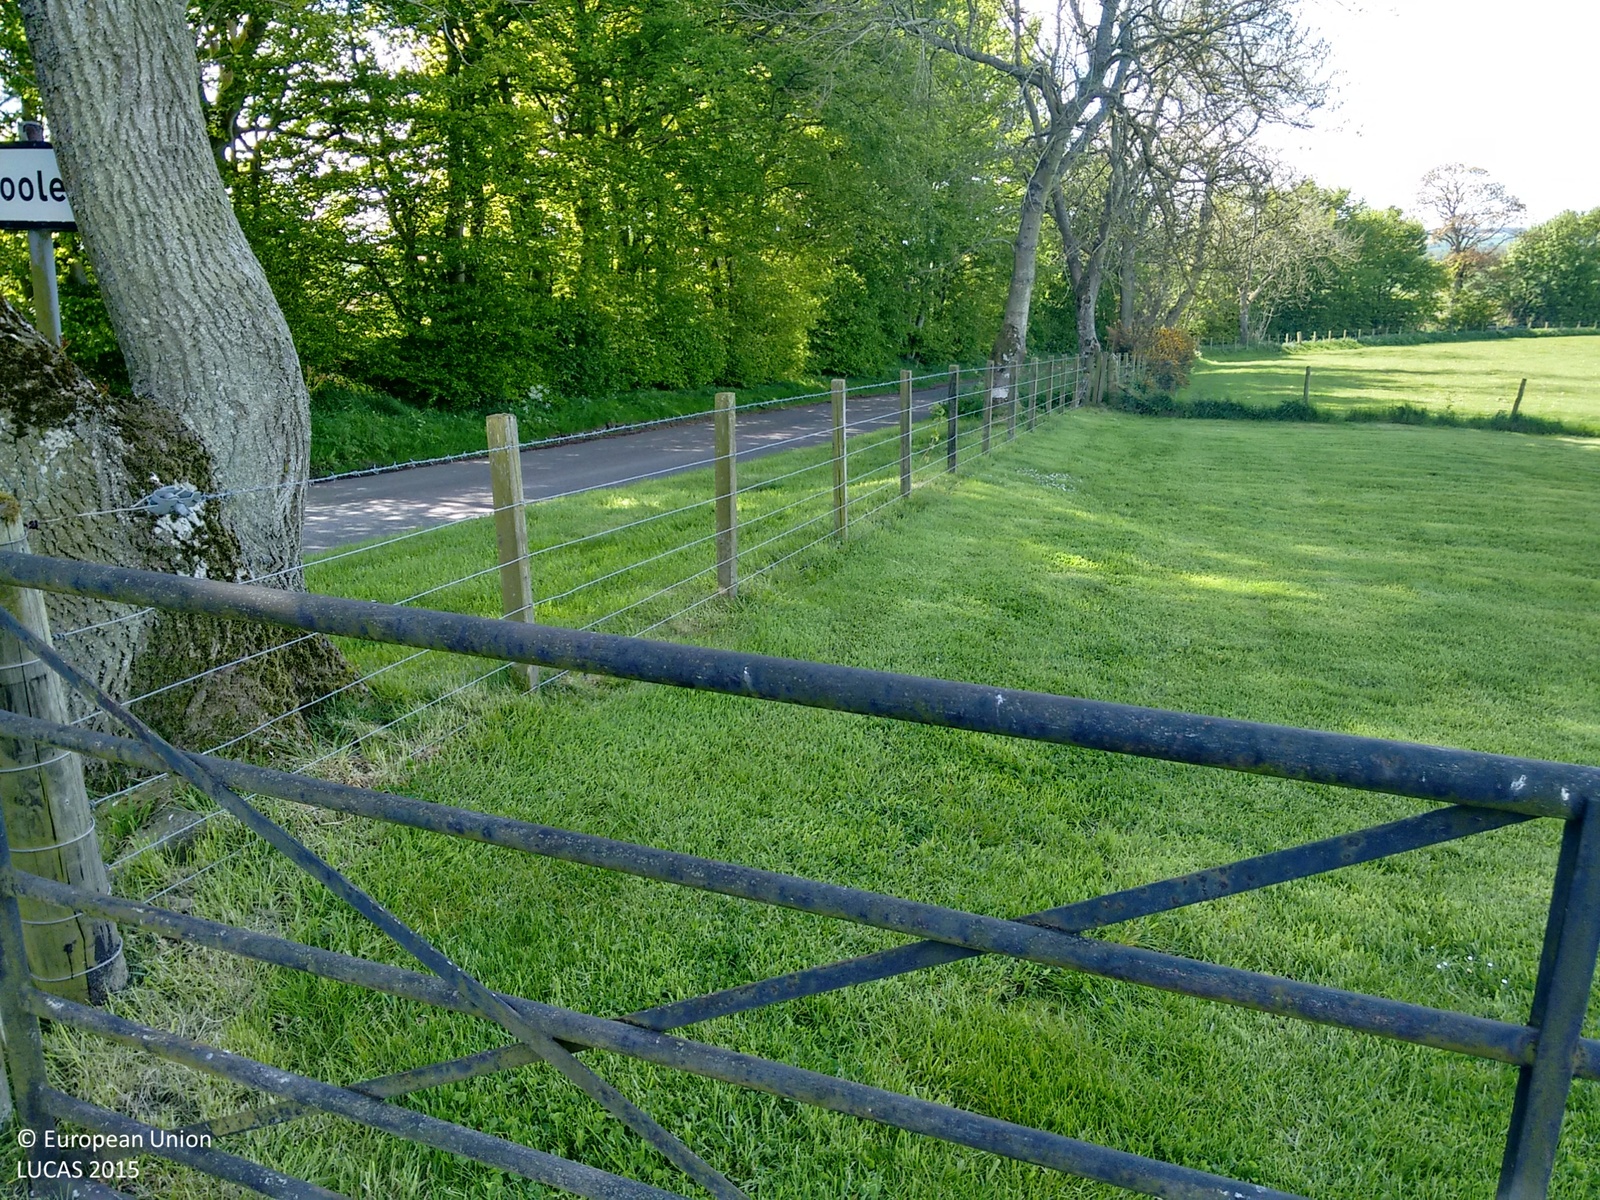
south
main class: Grassland
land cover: Grassland without tree/shrub cover
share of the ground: > 75 %
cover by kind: herbaceous plants 100 %
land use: Agriculture (excluding fallow land and kitchen gardens)
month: May
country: GB
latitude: 56.6568
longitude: -2.6028
